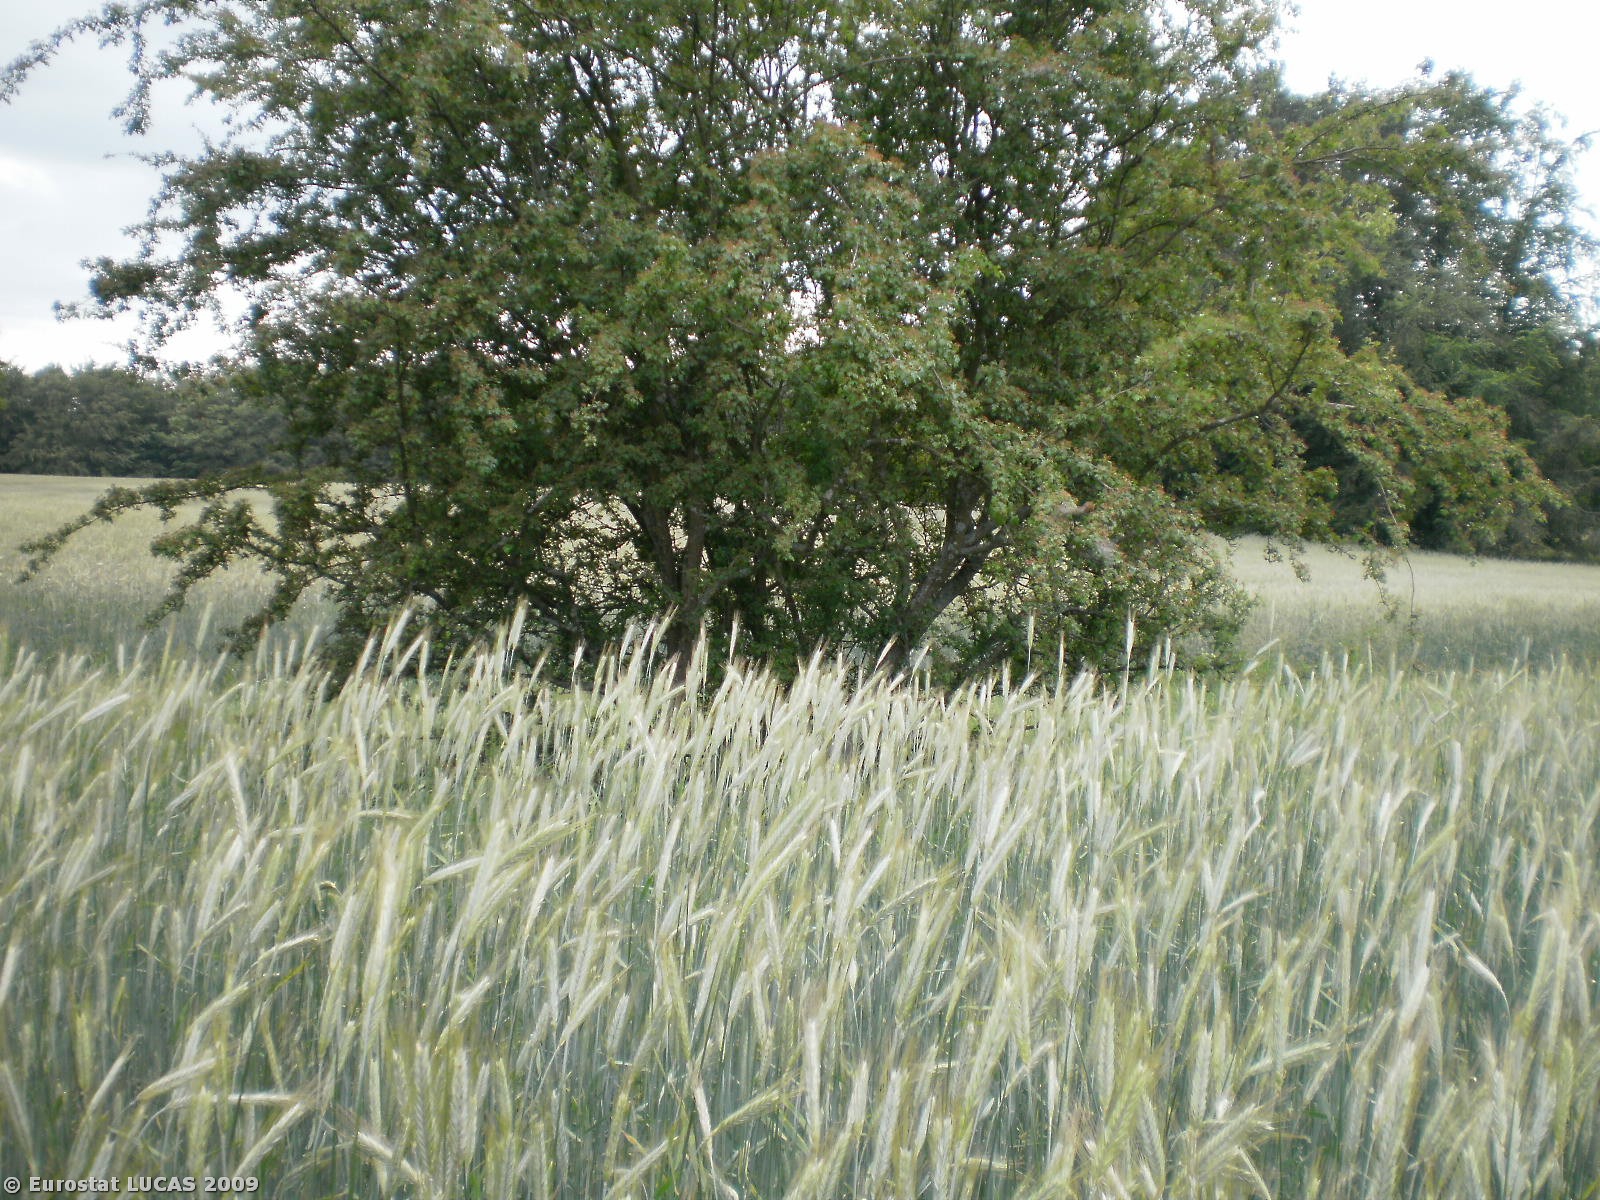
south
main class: Cropland
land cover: Rye
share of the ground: > 75 %
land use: Agriculture (excluding fallow land and kitchen gardens)
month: June
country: PL
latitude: 54.7502
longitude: 17.9206
